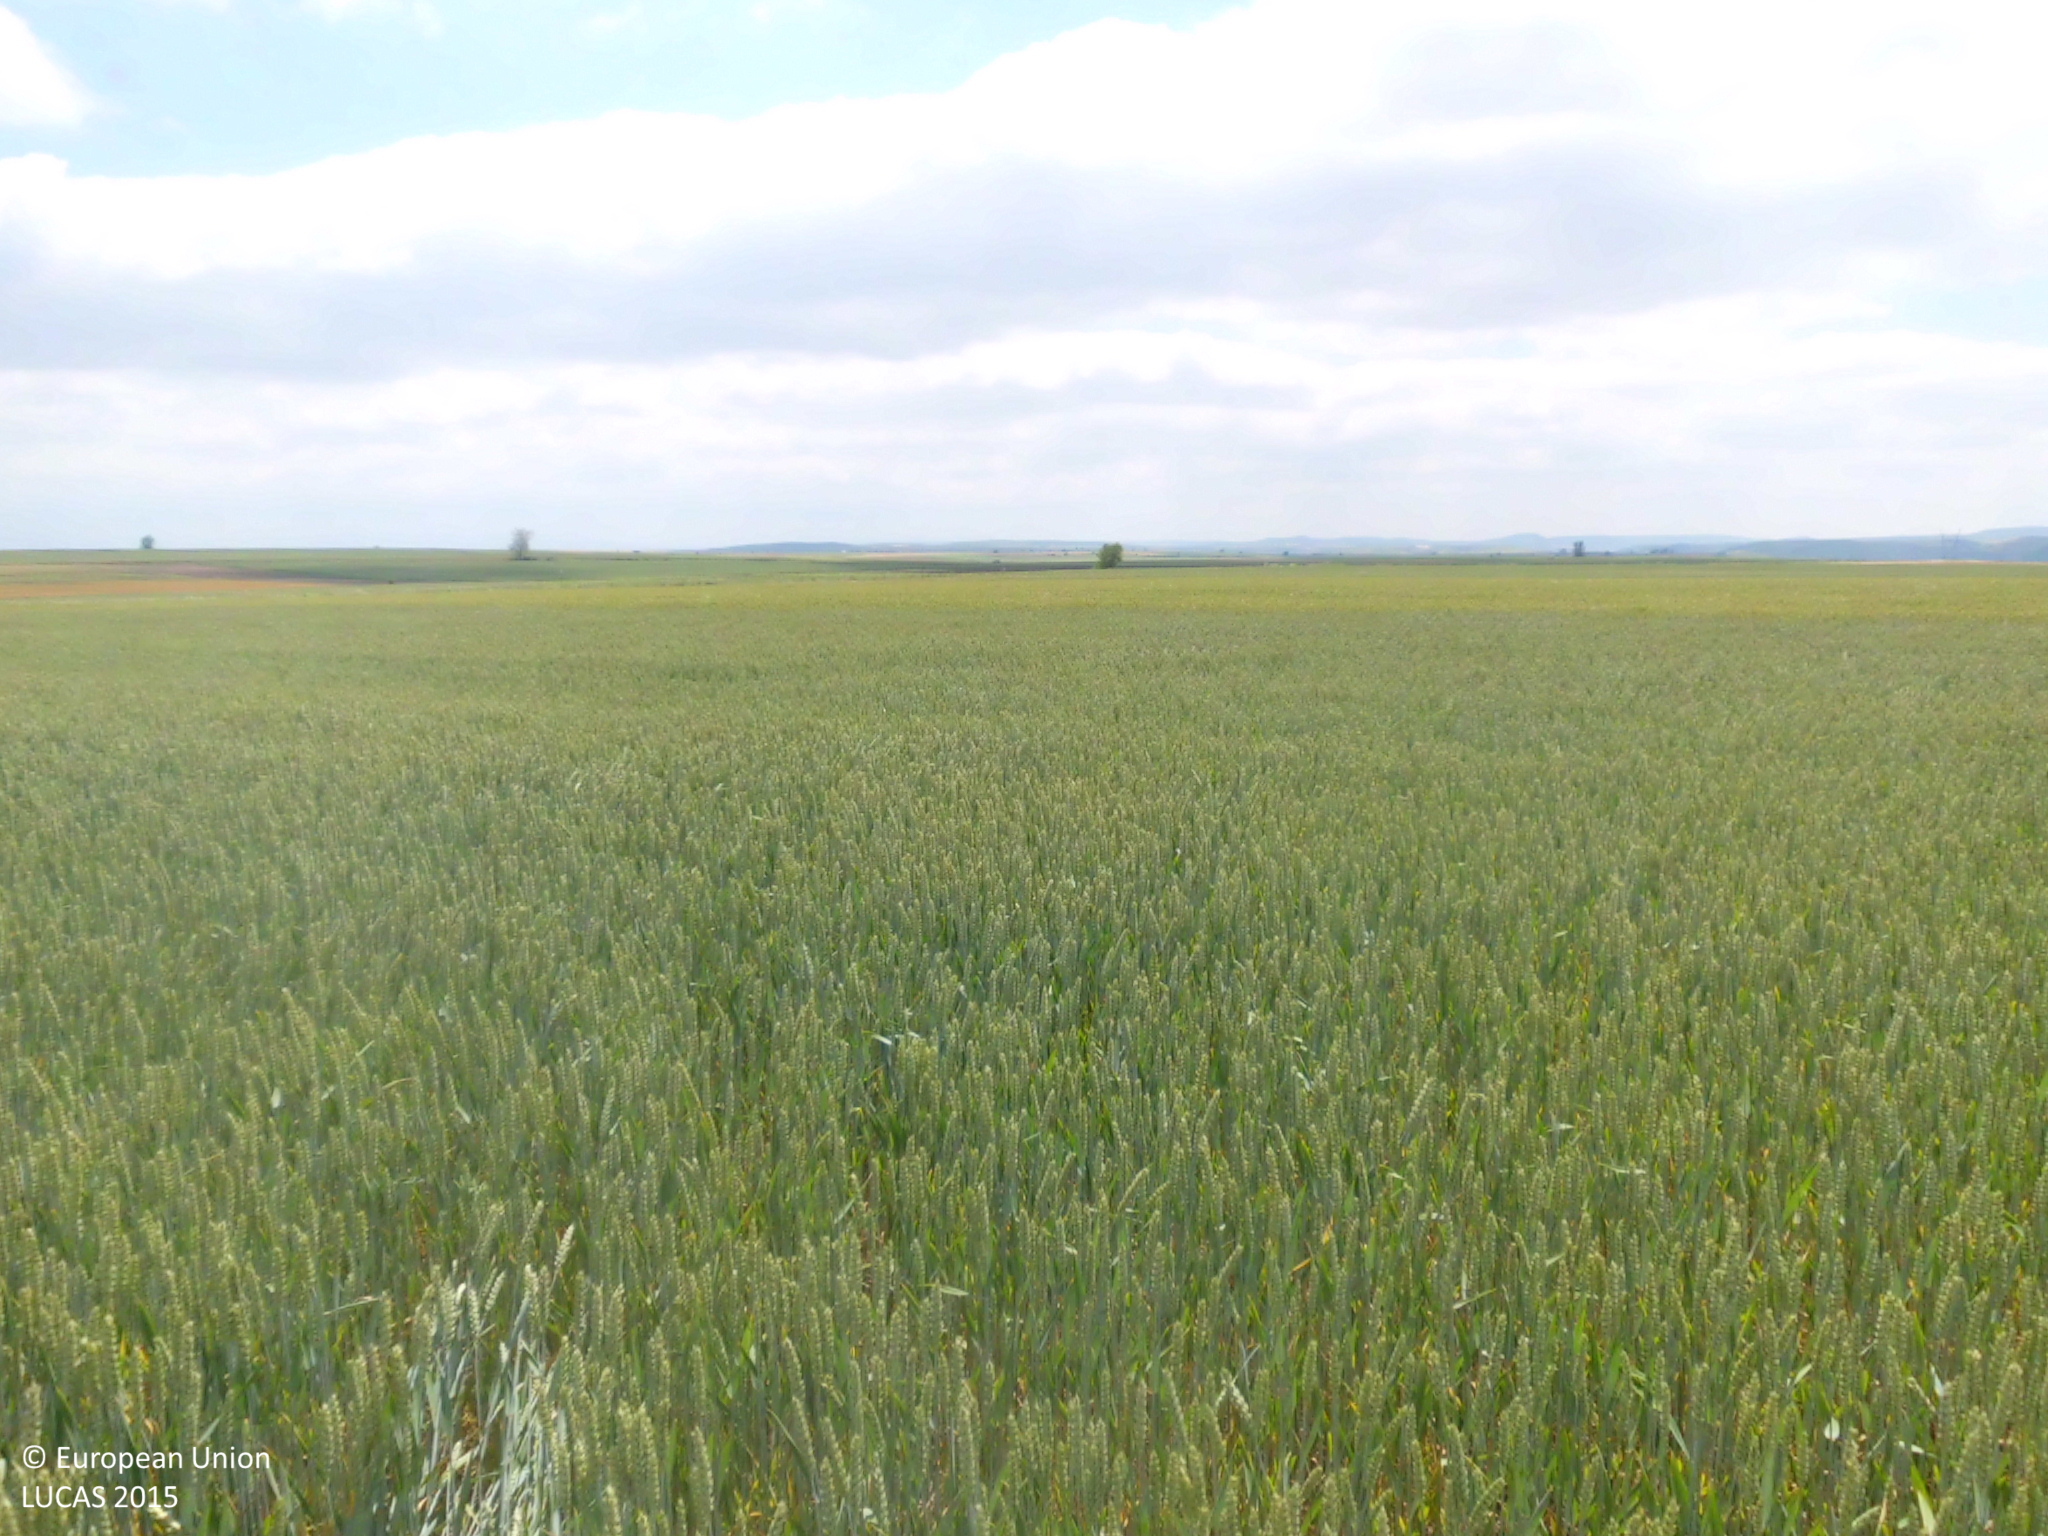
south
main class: Cropland
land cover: Common wheat
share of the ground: > 75 %
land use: Agriculture (excluding fallow land and kitchen gardens)
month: June
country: ES
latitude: 42.5799
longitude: -3.2765
